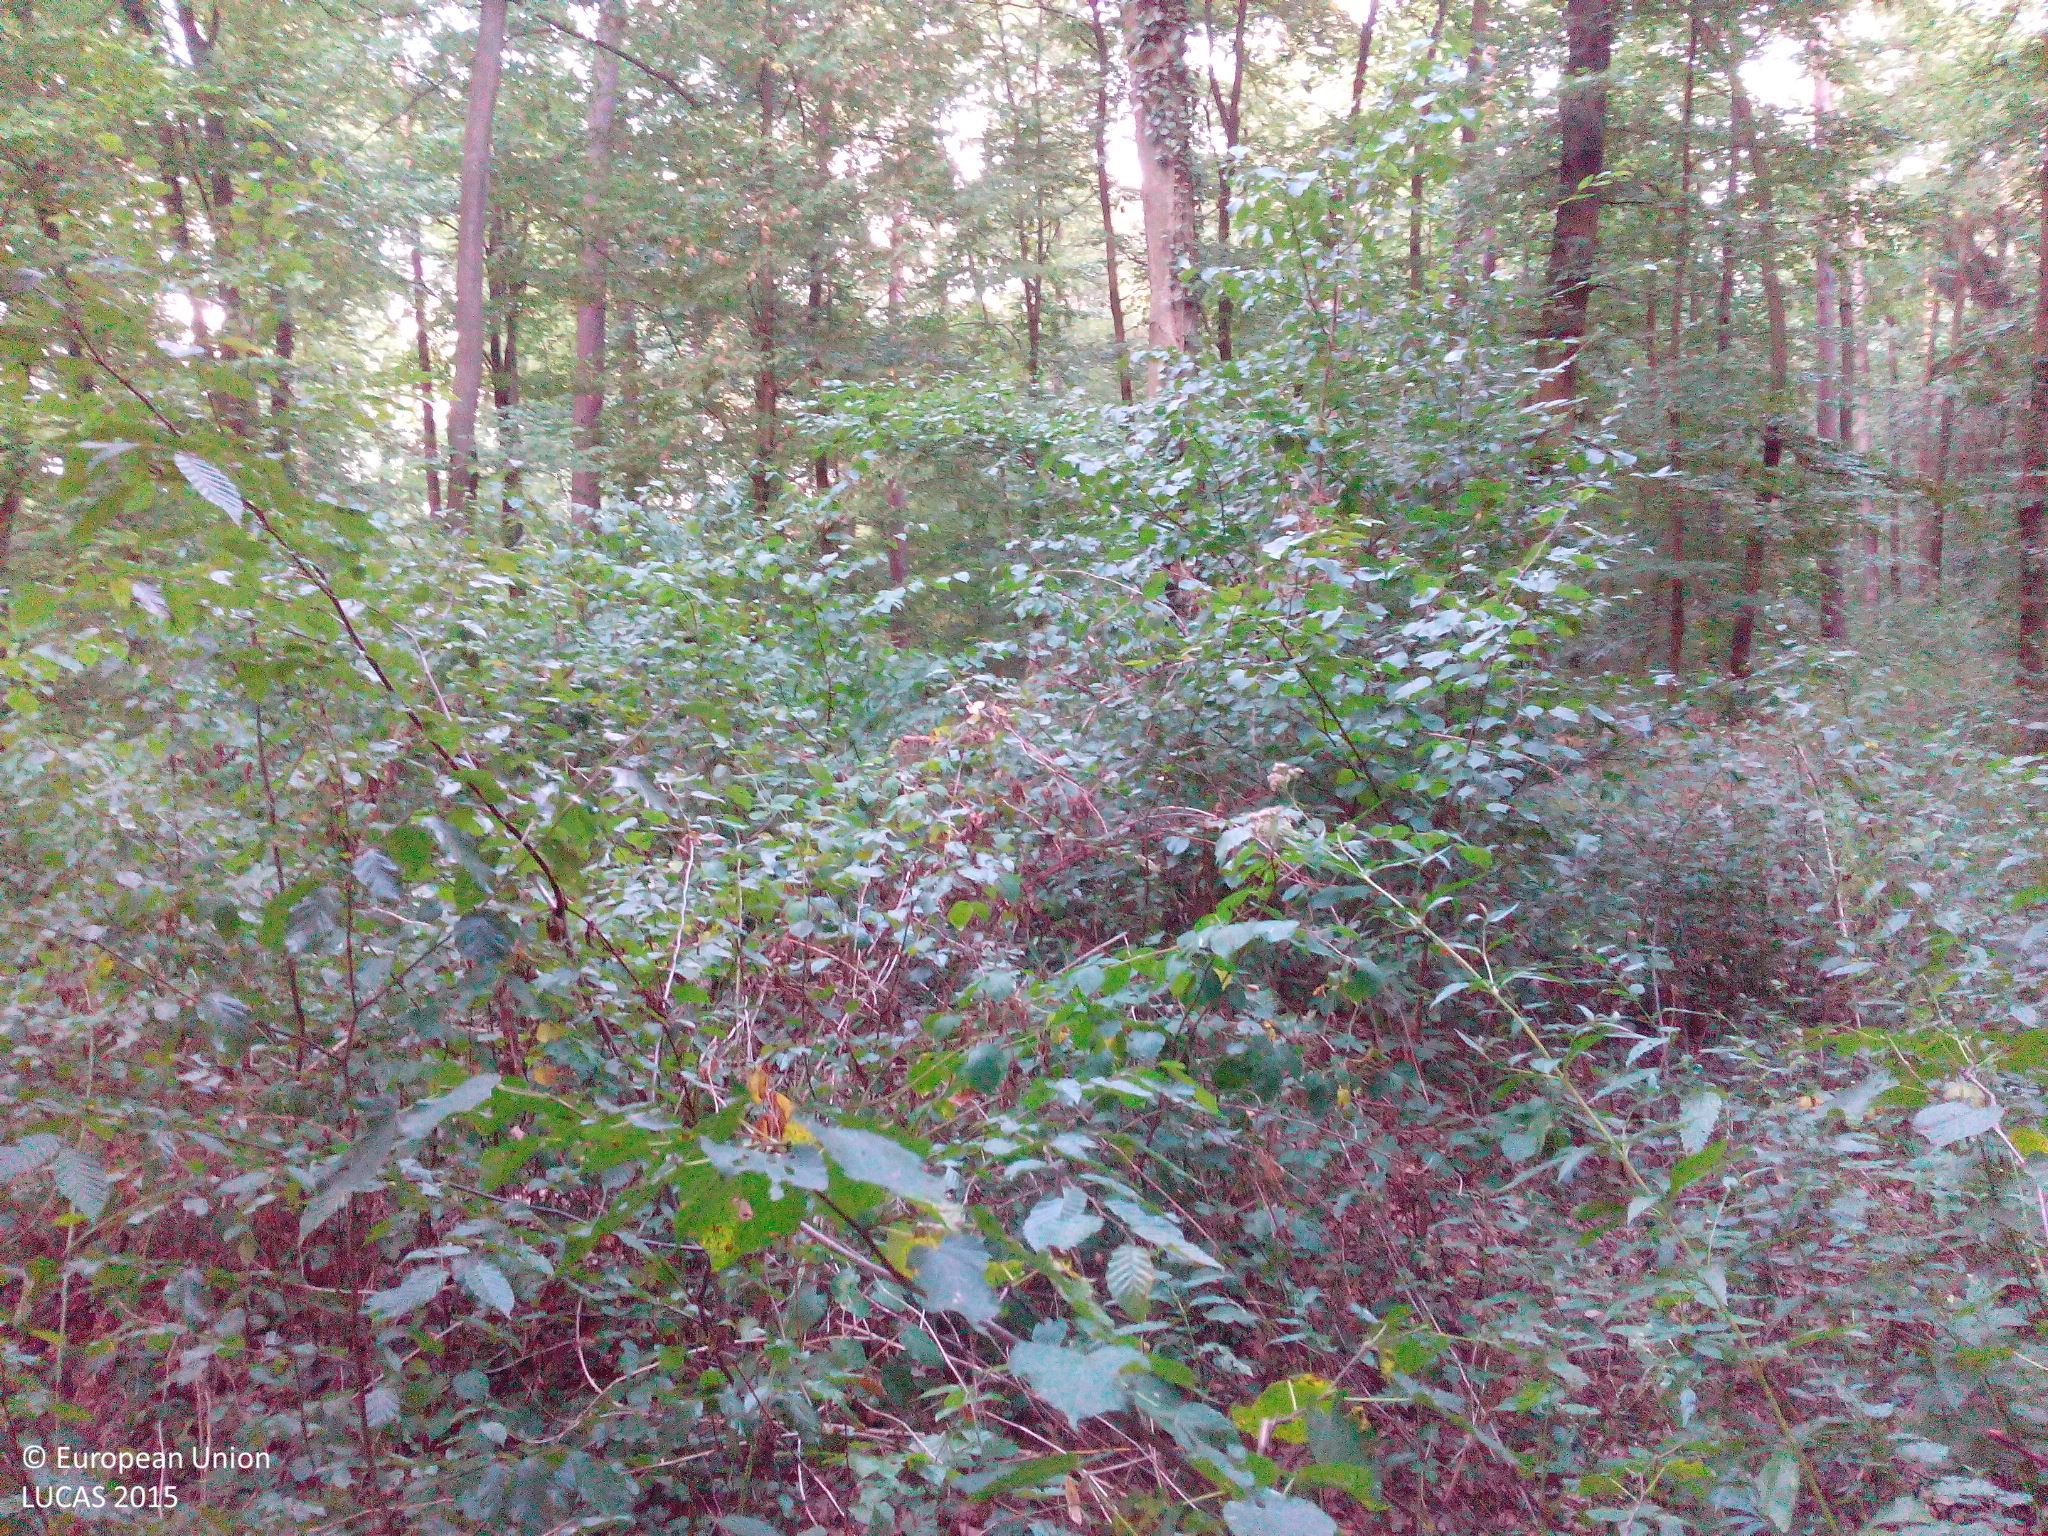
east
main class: Woodland
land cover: Pine dominated mixed woodland
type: hemiboreal forest and nemoral coniferous forest and mixed broadleaved-coniferous forest
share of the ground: > 75 %
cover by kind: broadleaved forest trees 60 %, coniferous forest trees 20 %, herbaceous plants 10 %, shrubs 5 %, unconsolidated bare surface 5 %
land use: Forestry
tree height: > 5 m
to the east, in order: Pine dominated mixed woodland; Tracks; Broadleaved woodland
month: August
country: DE
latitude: 49.2757
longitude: 8.5573
